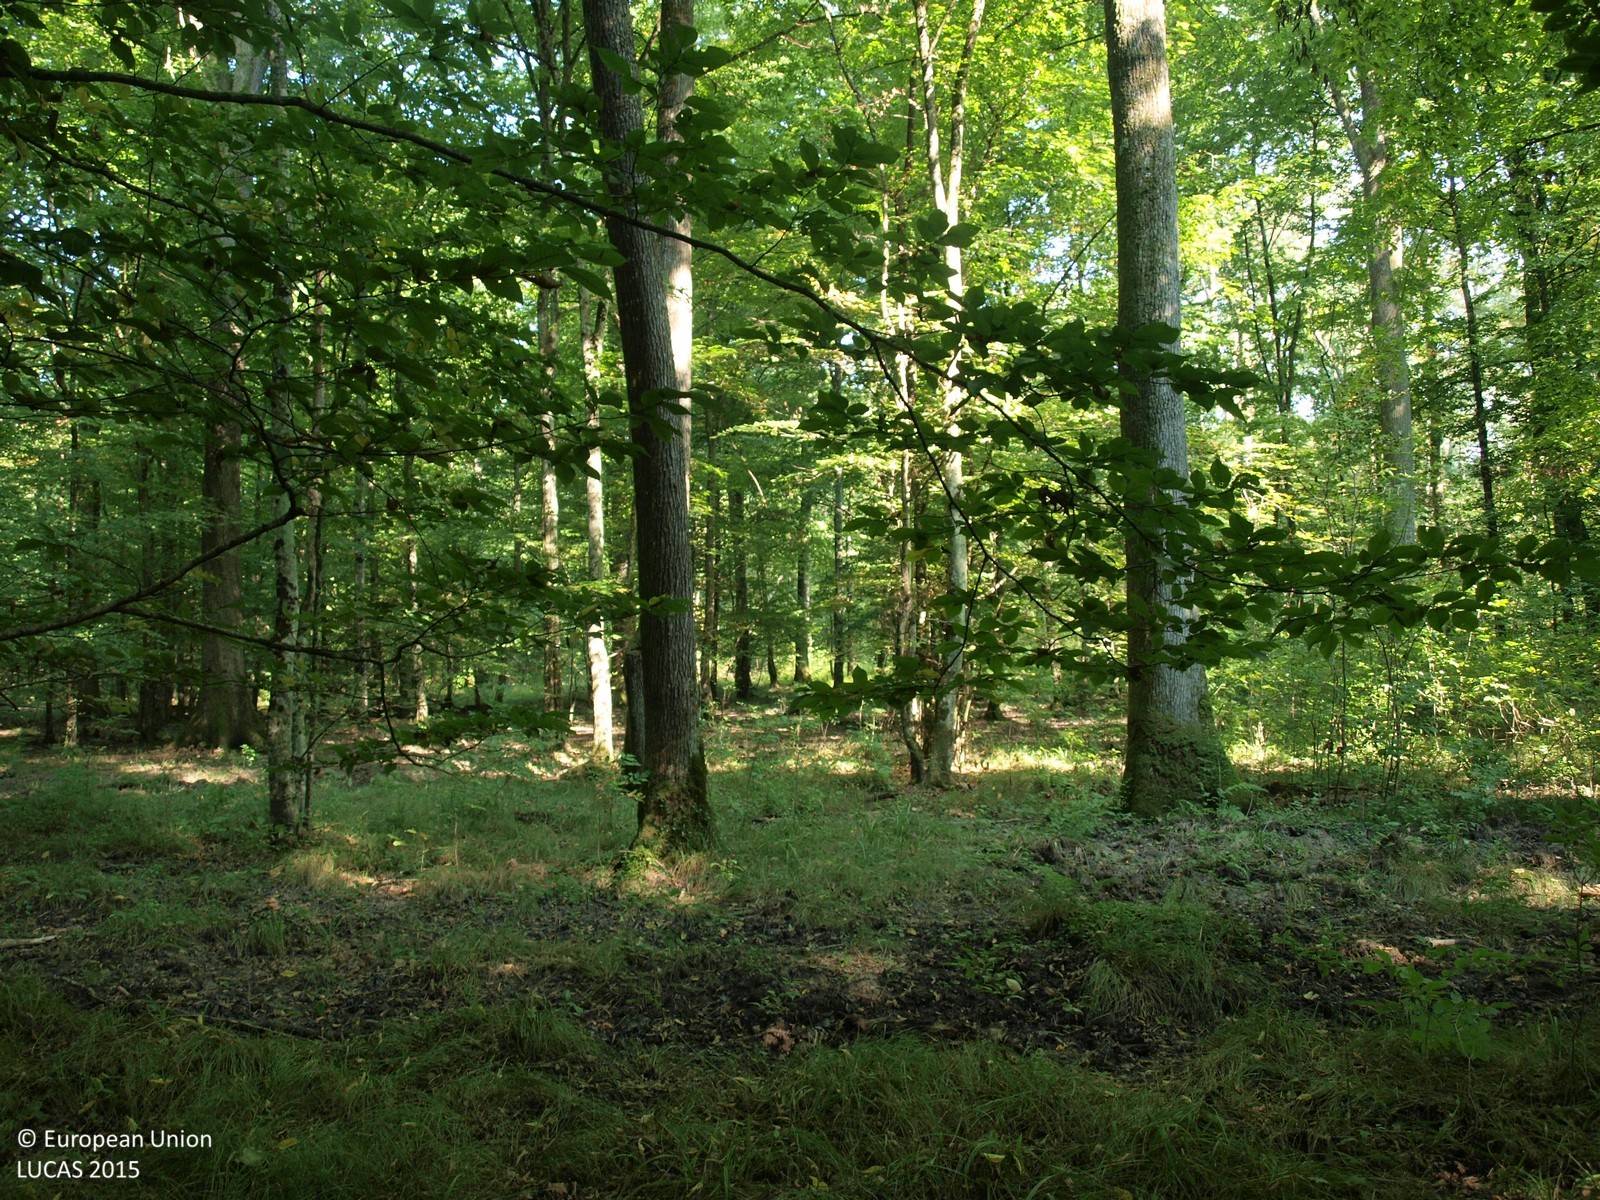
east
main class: Woodland
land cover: Broadleaved woodland
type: floodplain forest
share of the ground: > 75 %
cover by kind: broadleaved forest trees 100 %
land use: Forestry
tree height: > 5 m
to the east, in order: Broadleaved woodland; Tracks; Broadleaved woodland
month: August
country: HR
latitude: 45.6145
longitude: 16.4487
